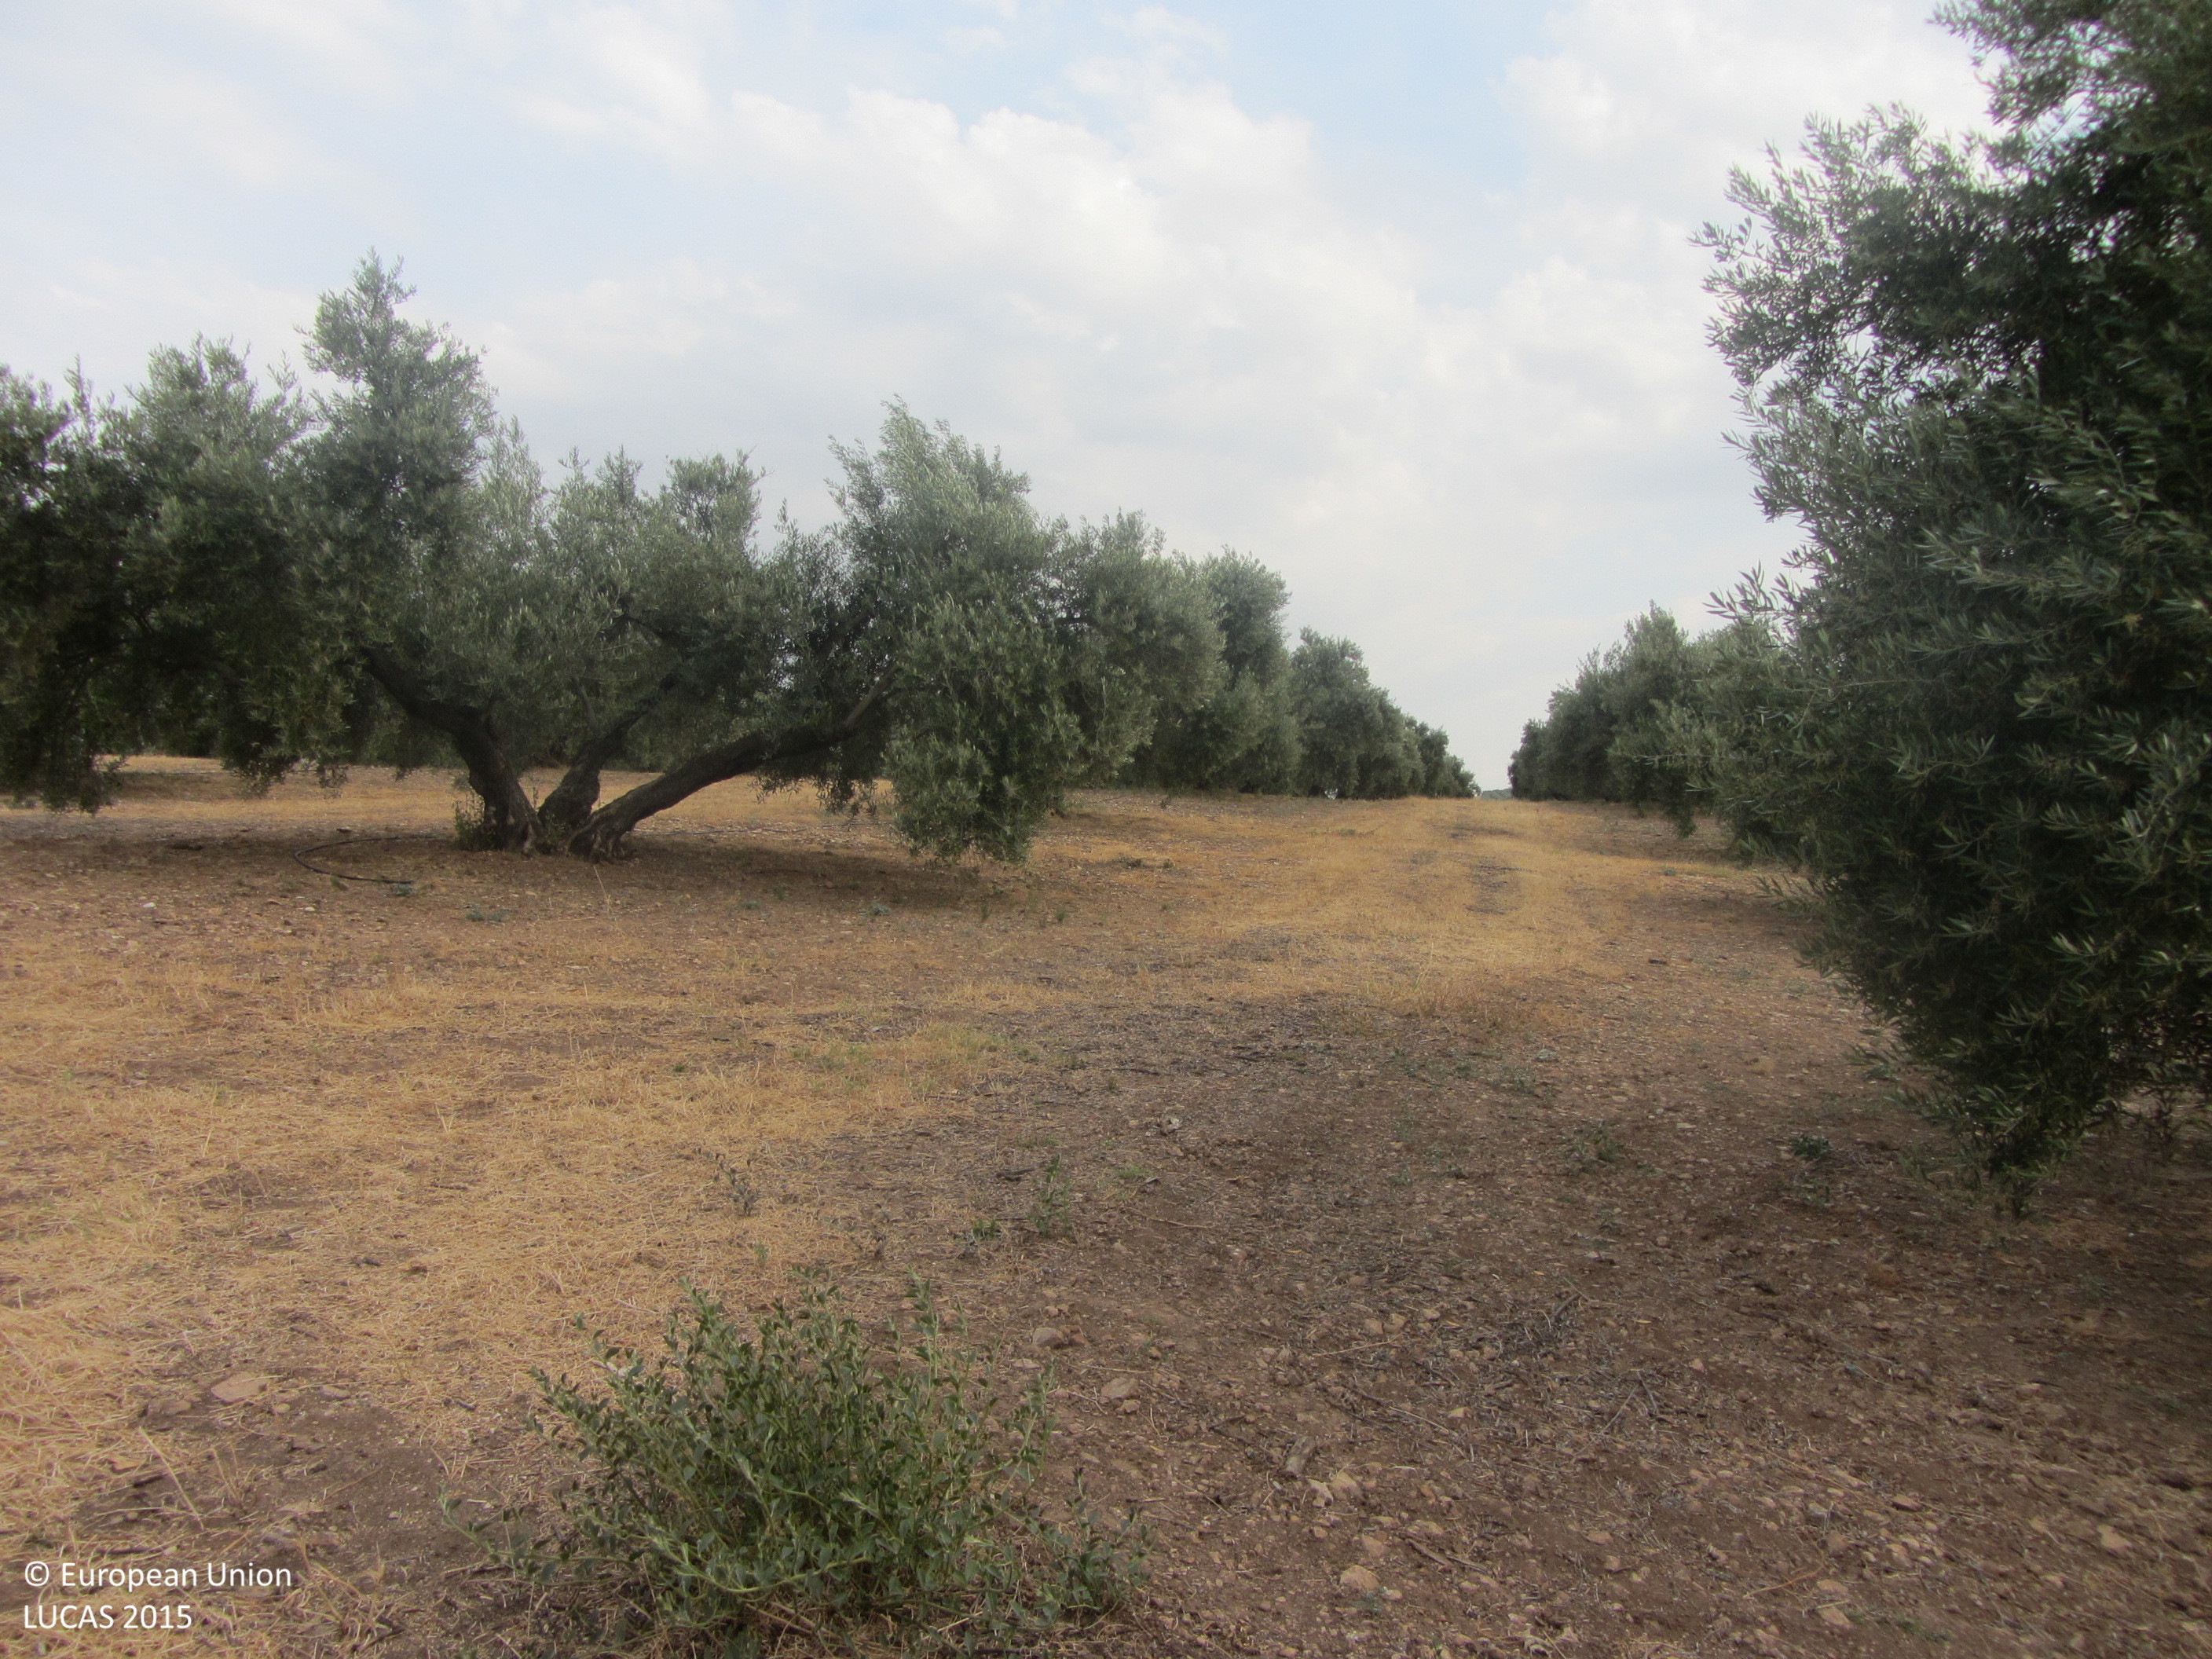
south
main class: Woodland
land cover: Broadleaved woodland
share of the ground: > 75 %
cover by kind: broadleaved forest trees 90 %, shrubs 10 %
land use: Semi-natural and natural areas not in use
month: June
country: ES
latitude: 38.1162
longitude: -3.2657
